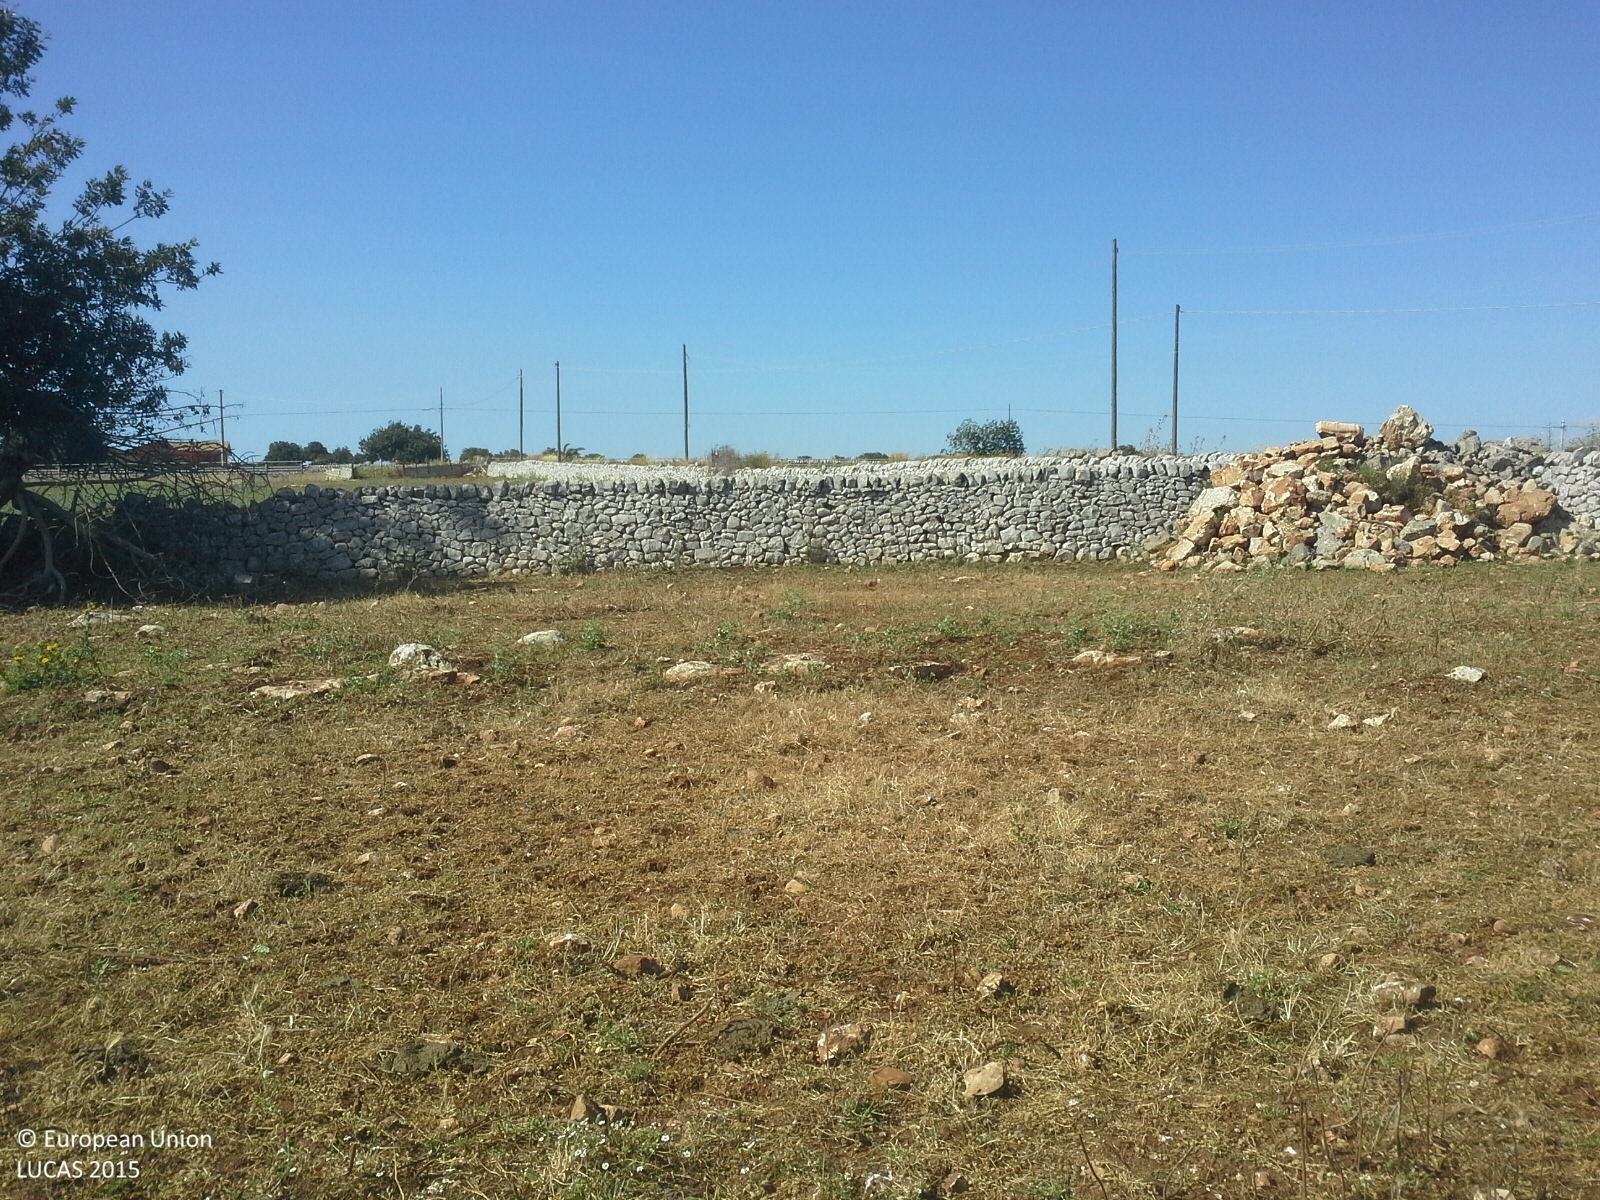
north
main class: Cropland
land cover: Mixed cereals for fodder
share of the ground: > 75 %
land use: Agriculture (excluding fallow land and kitchen gardens)
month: May
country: IT
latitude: 36.8058
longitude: 14.8368
